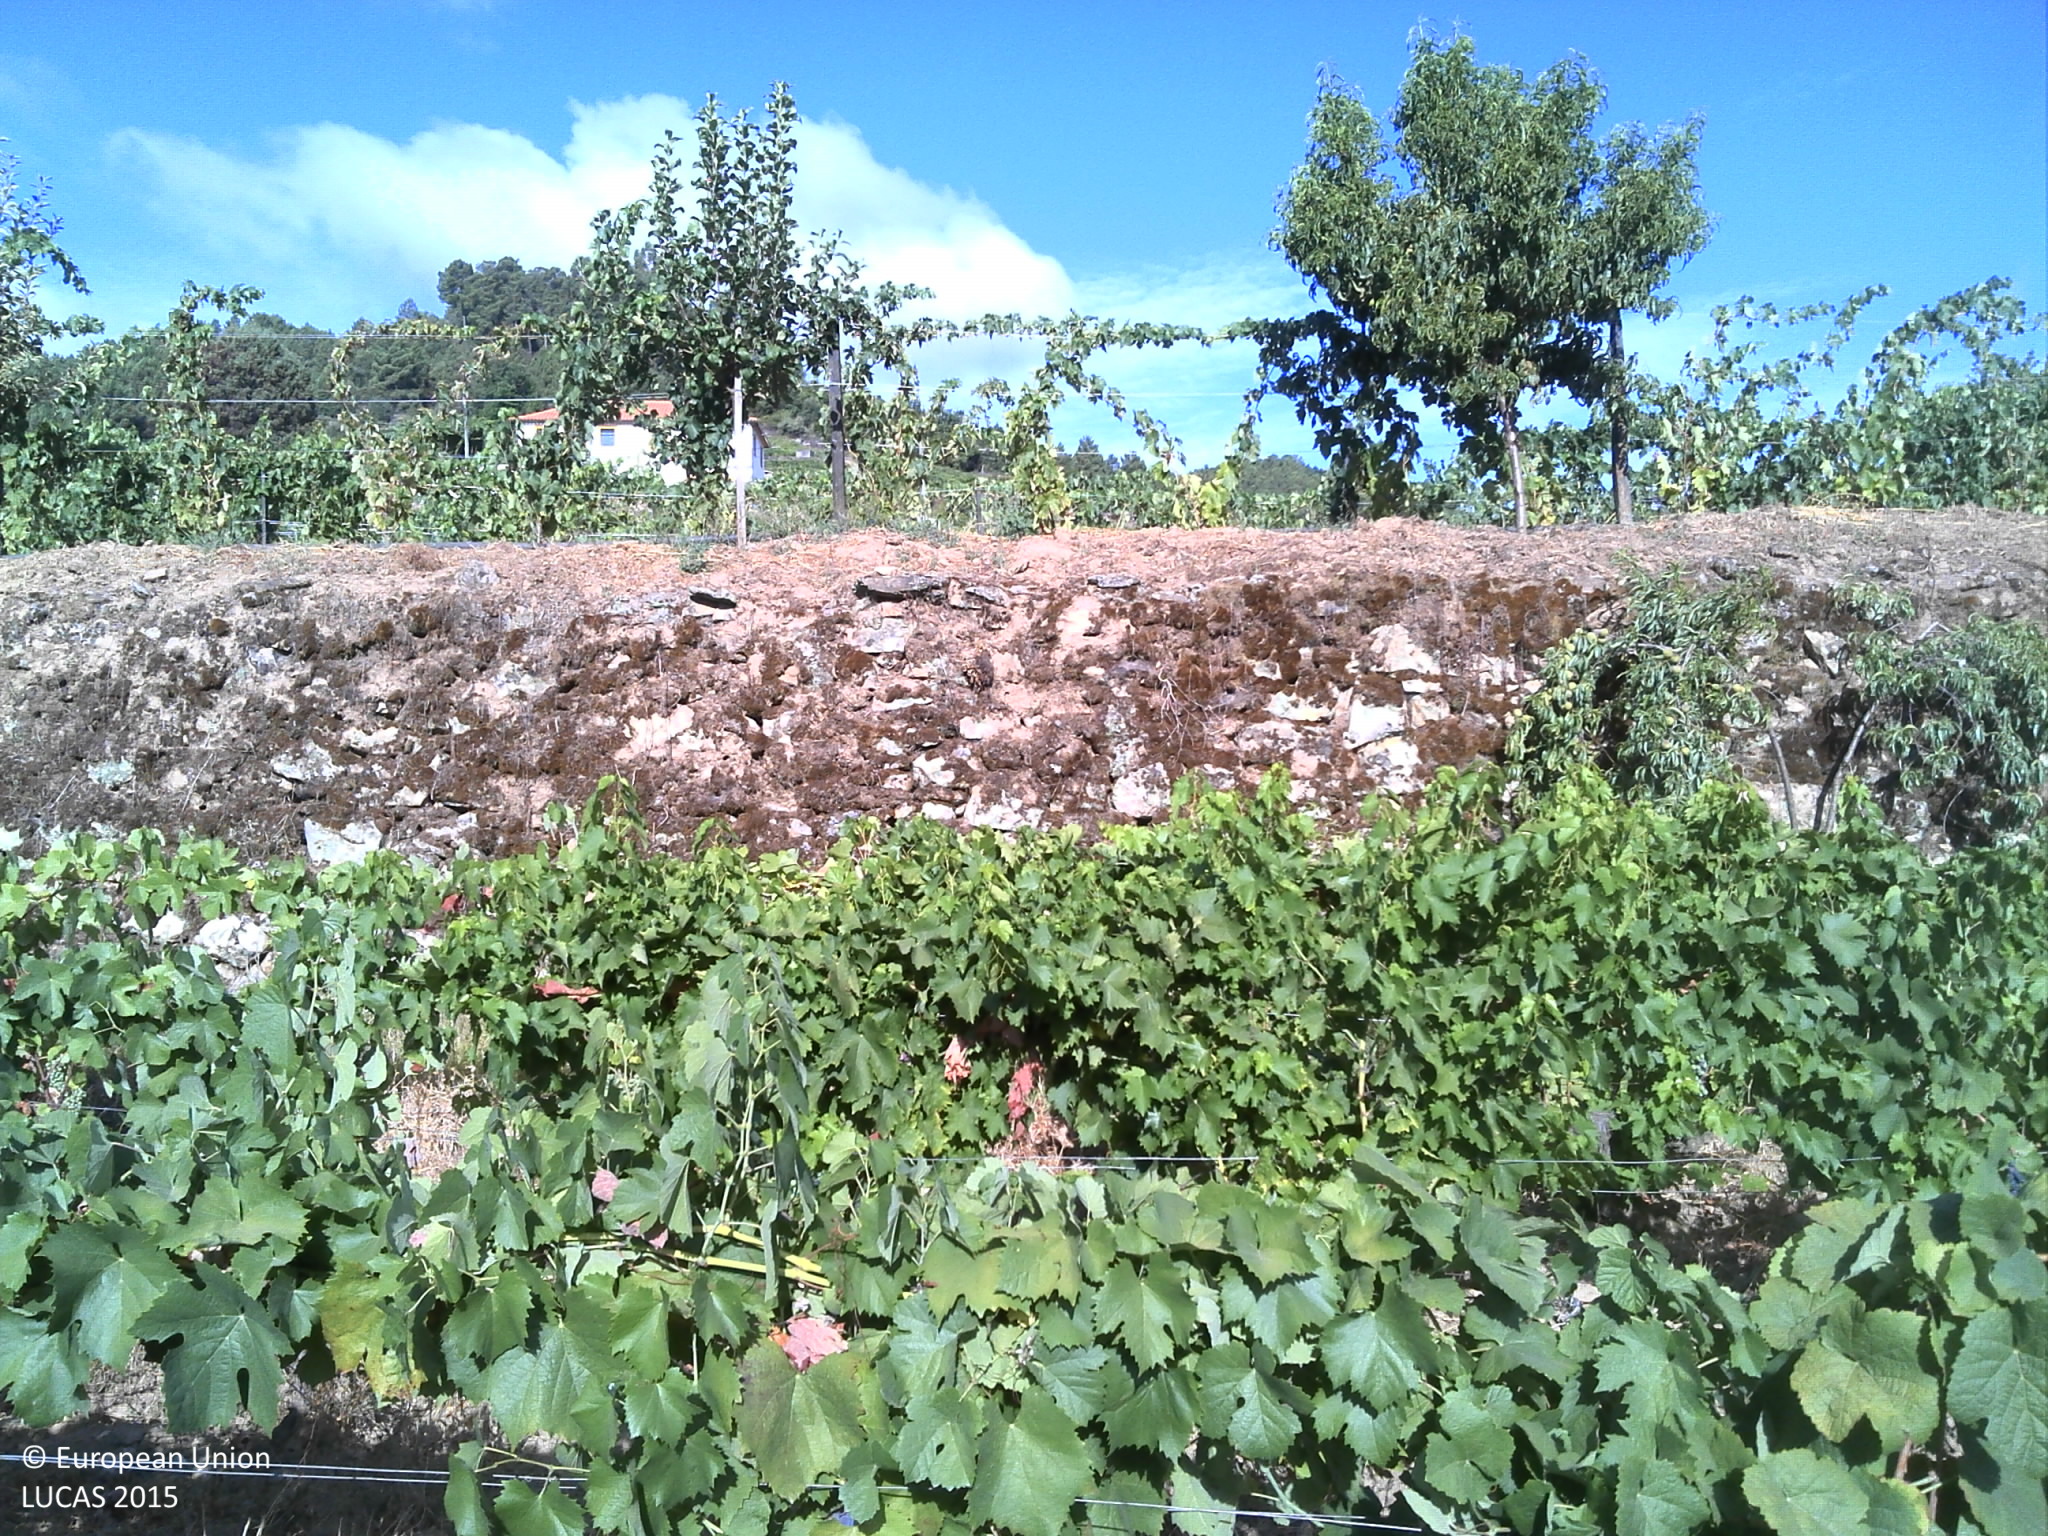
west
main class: Cropland
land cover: Vineyards
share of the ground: < 10 %
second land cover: Grassland without tree/shrub cover
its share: 50 - 75 %
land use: Agriculture (excluding fallow land and kitchen gardens)
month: July
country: PT
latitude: 41.2563
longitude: -7.4393
